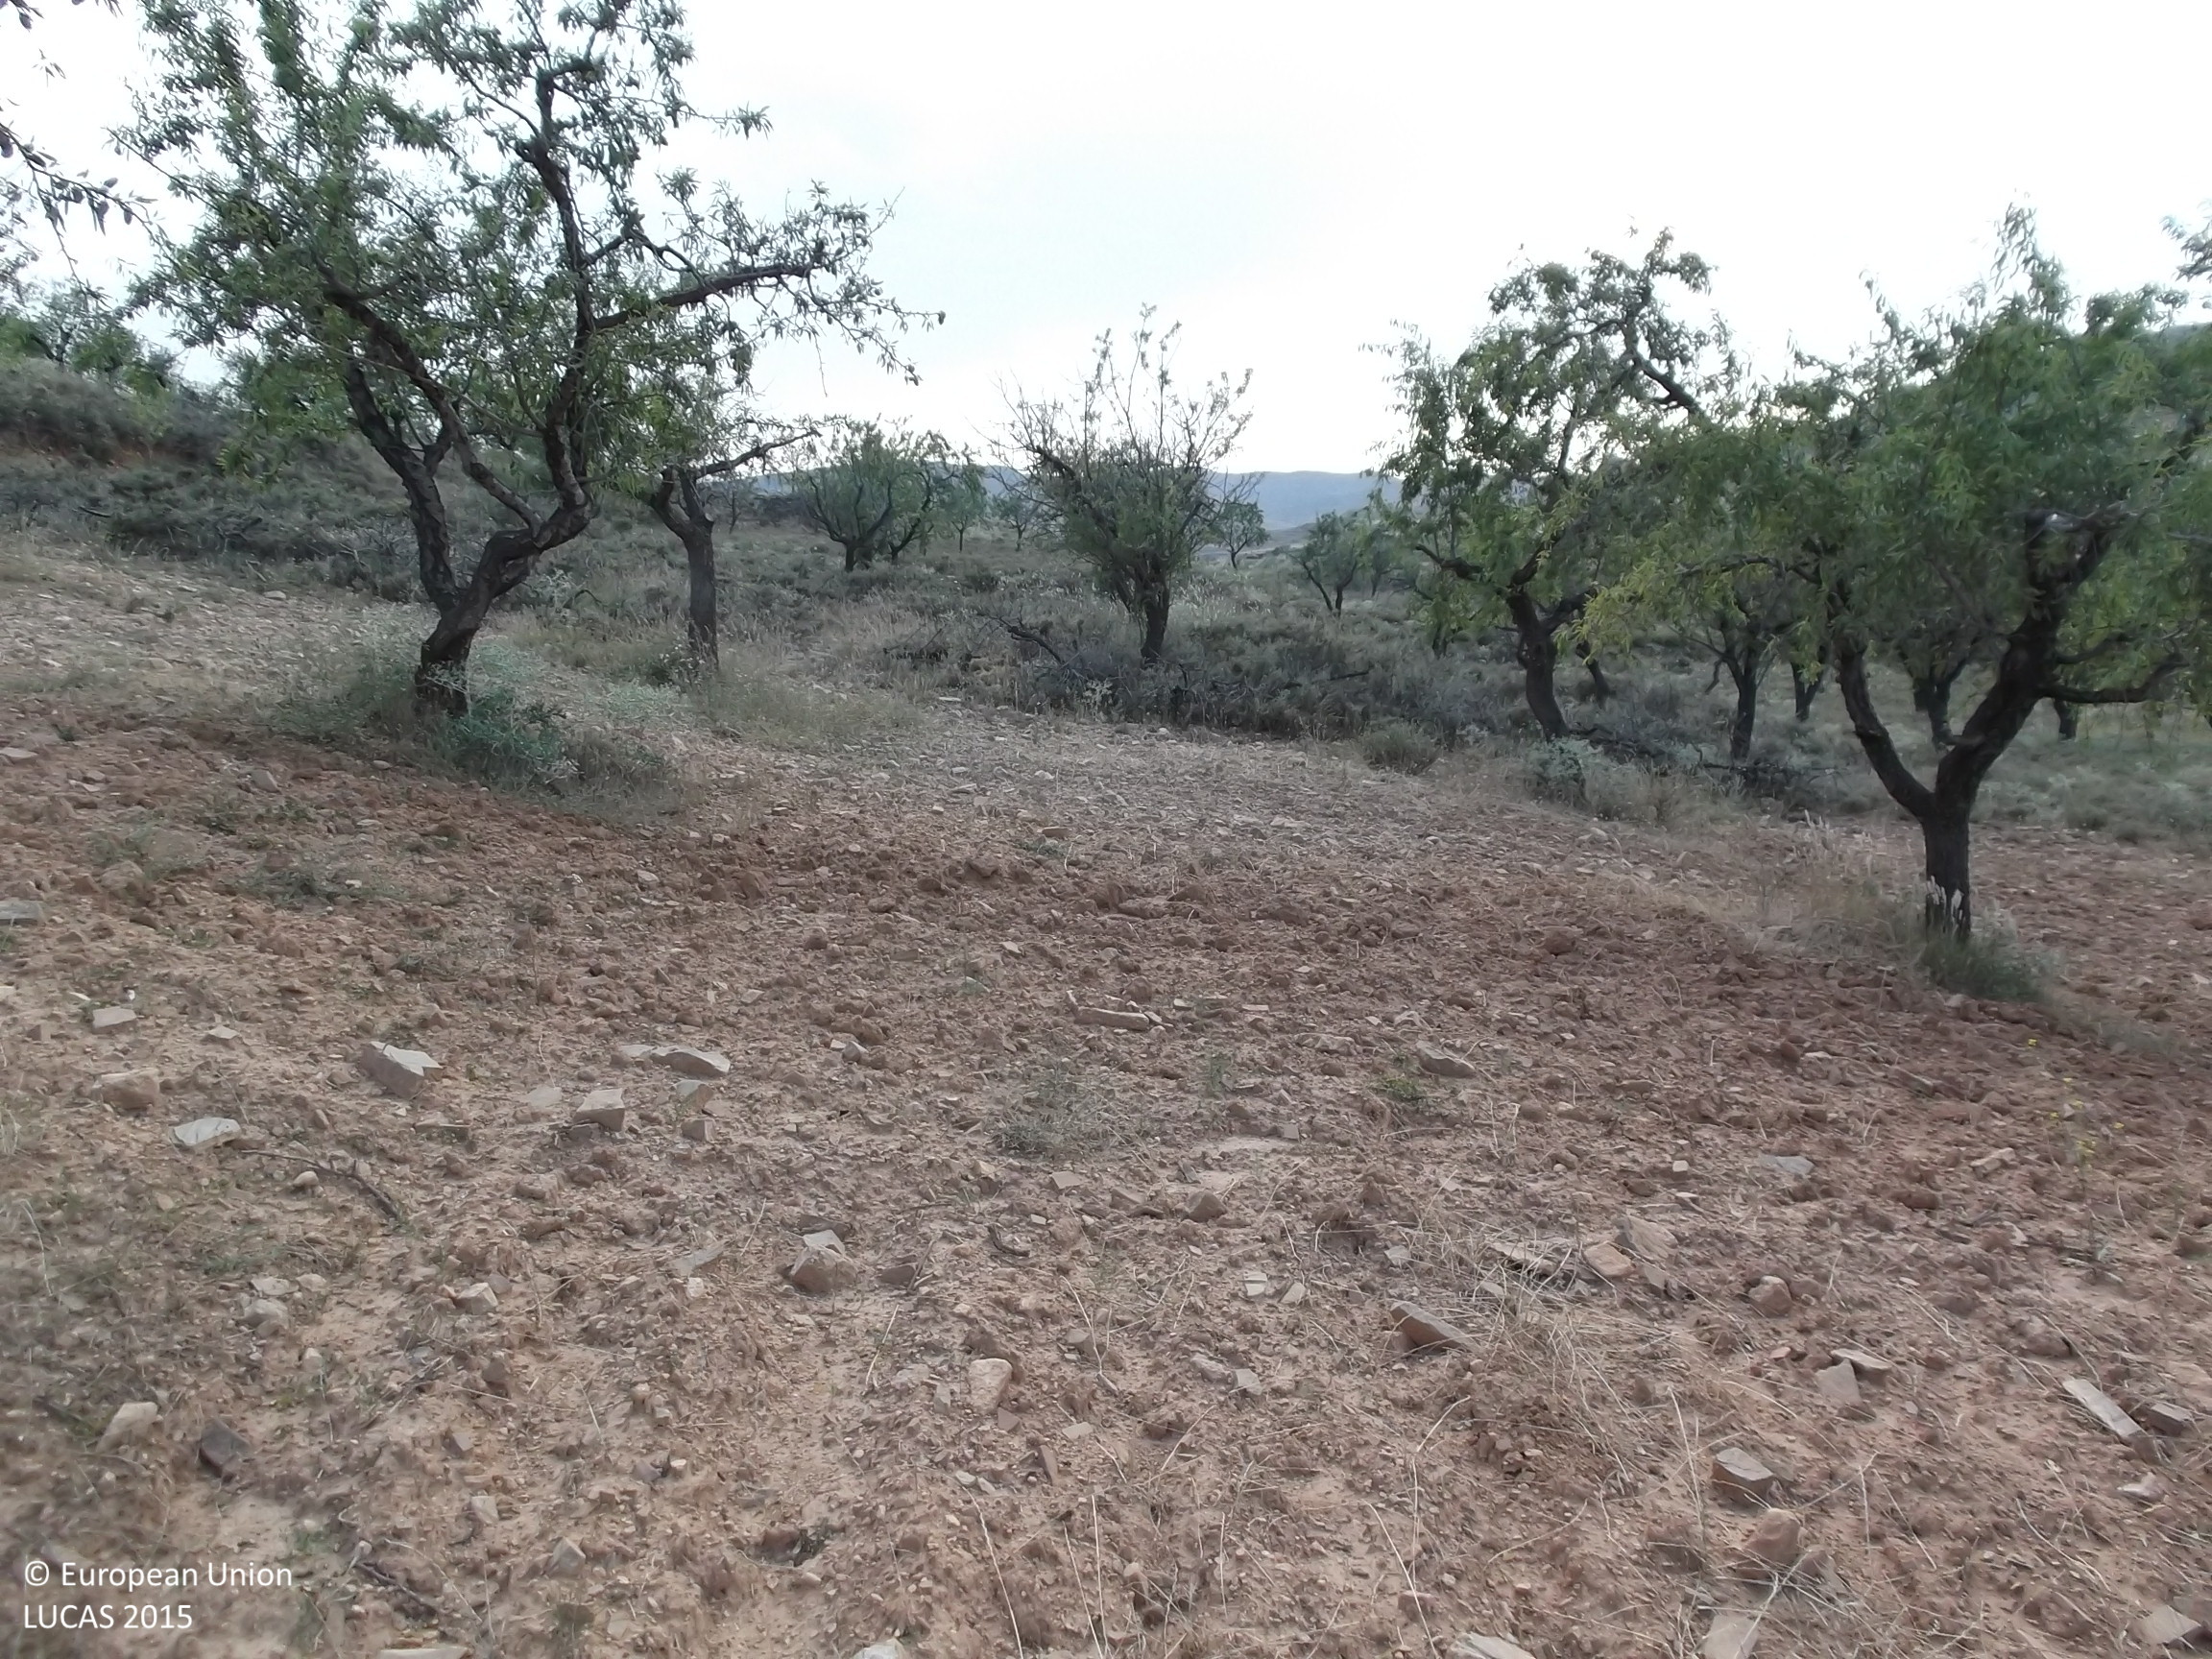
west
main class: Cropland
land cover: Nuts trees
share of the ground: 25 - 50 %
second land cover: Other bare soil
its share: > 75 %
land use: Agriculture (excluding fallow land and kitchen gardens)
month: July
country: ES
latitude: 42.0641
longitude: -2.0121
